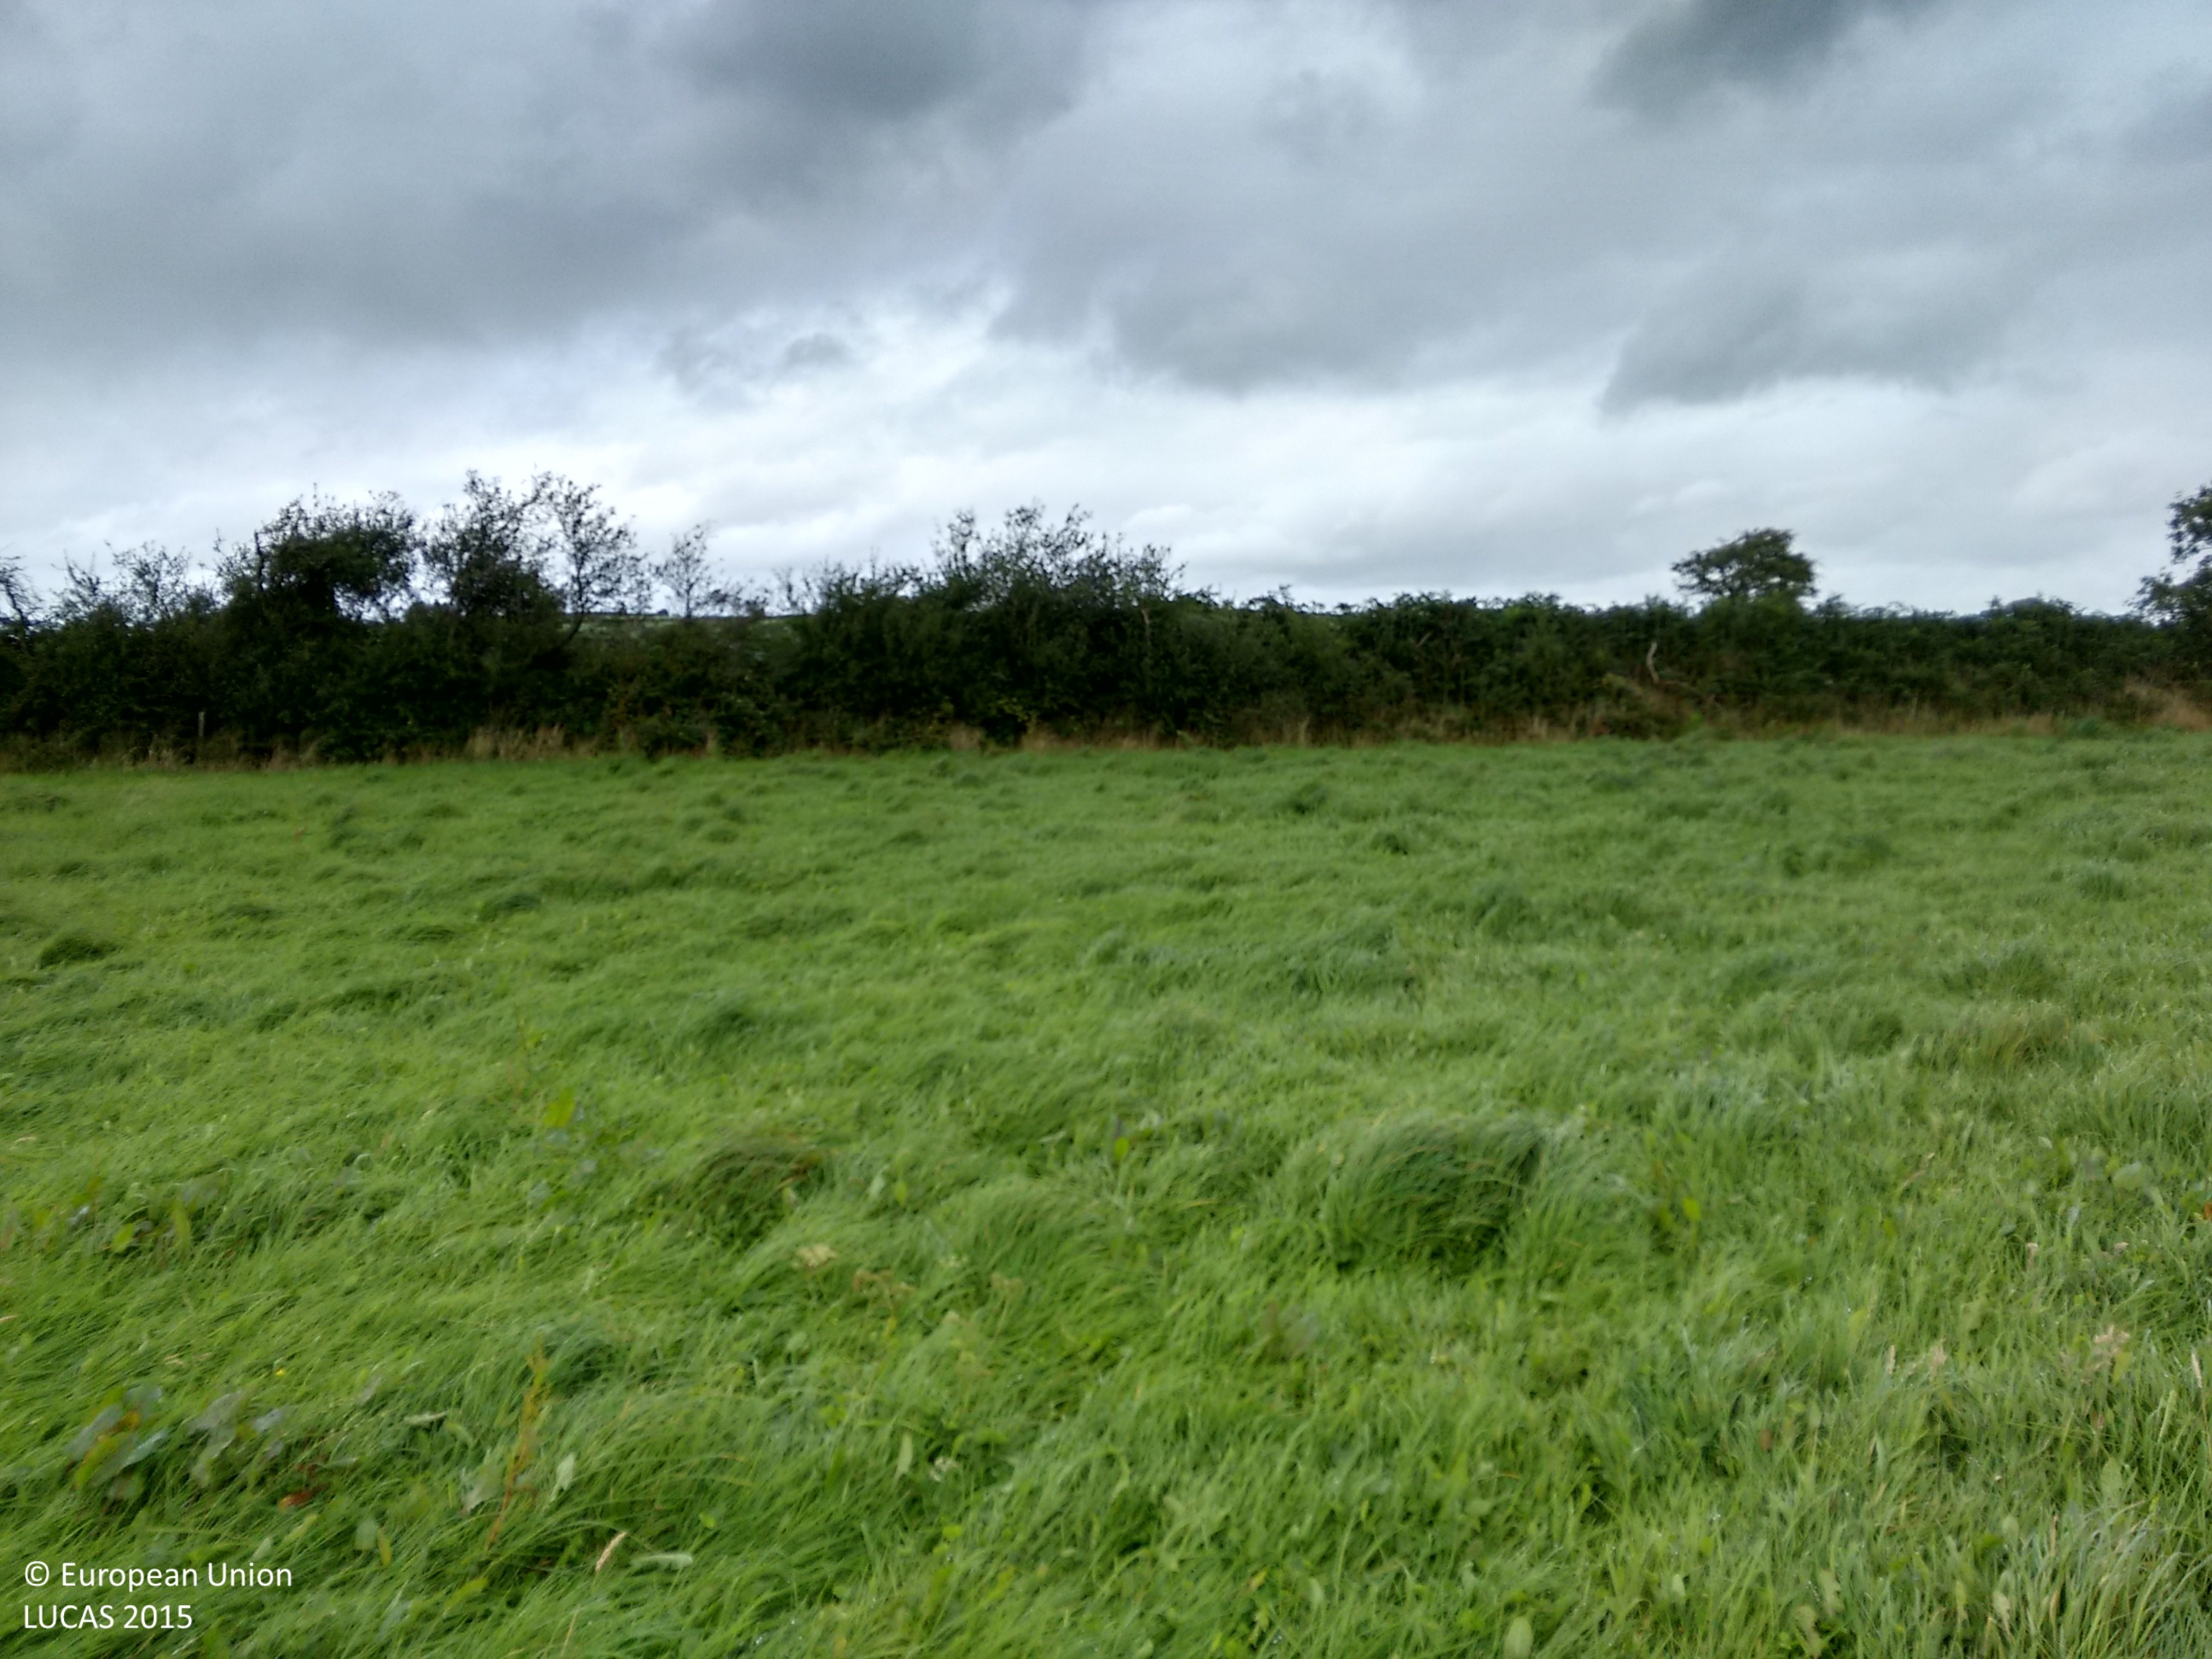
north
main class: Grassland
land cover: Grassland without tree/shrub cover
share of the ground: > 75 %
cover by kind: herbaceous plants 100 %
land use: Agriculture (excluding fallow land and kitchen gardens)
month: August
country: GB
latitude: 52.0123
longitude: -4.6347
